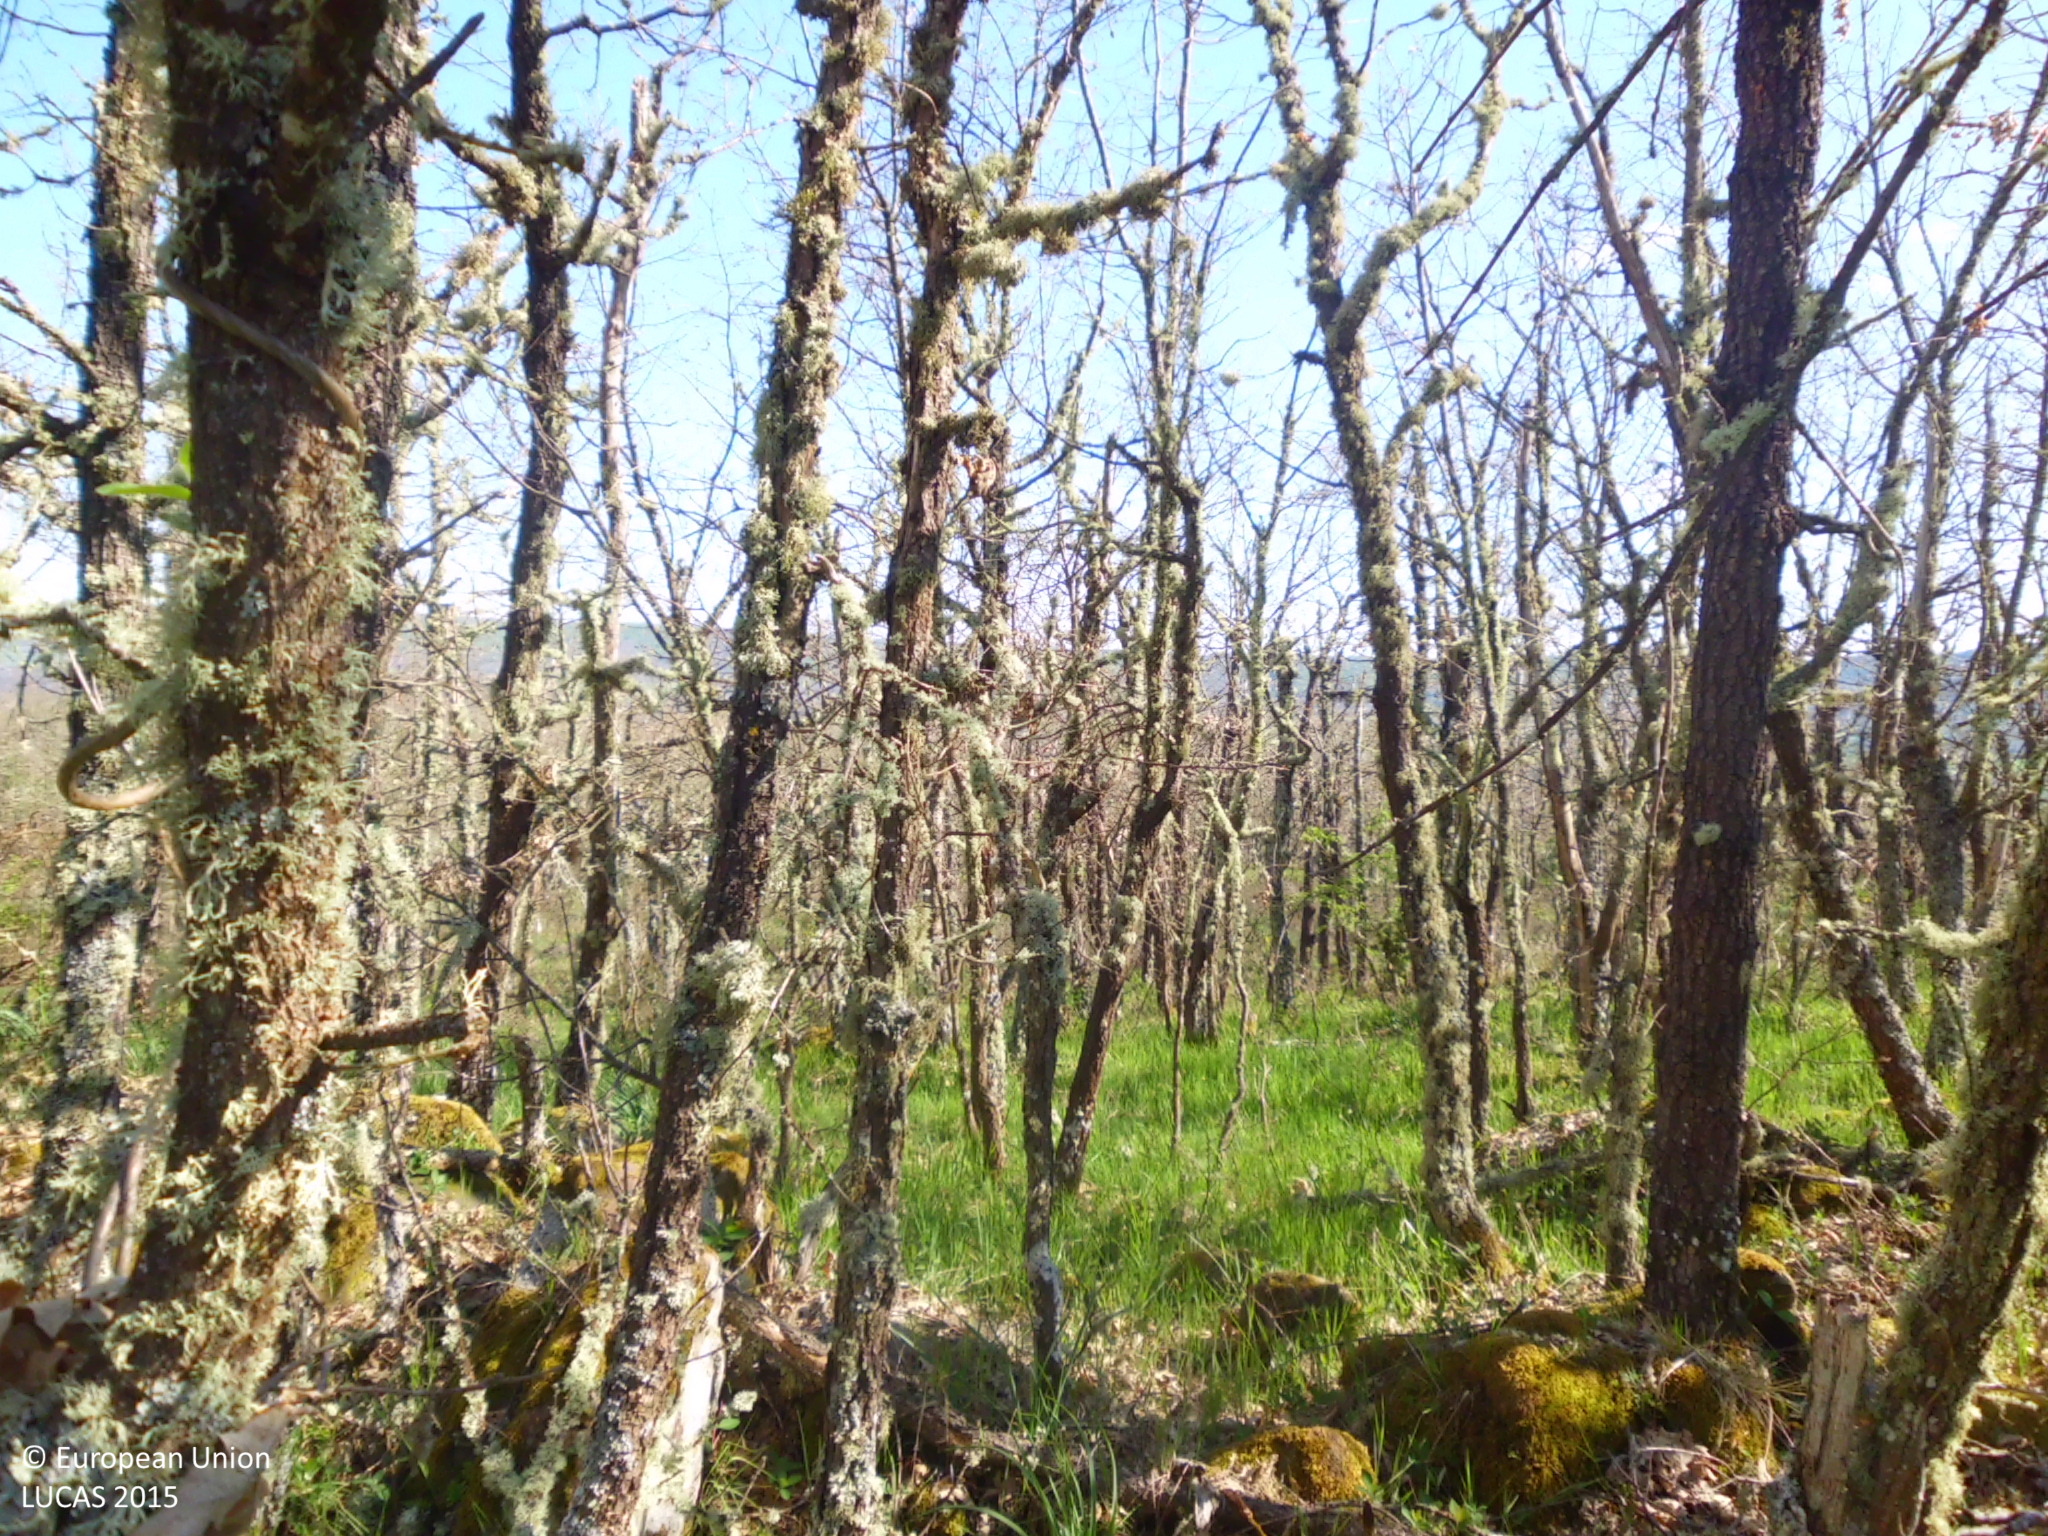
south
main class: Woodland
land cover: Broadleaved woodland
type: acidophilous oak and oak-birch forest
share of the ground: > 75 %
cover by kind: broadleaved forest trees 85 %, shrubs 10 %, herbaceous plants 5 %
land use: Semi-natural and natural areas not in use
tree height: < 5 m
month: May
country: ES
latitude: 42.8185
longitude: -4.0759
